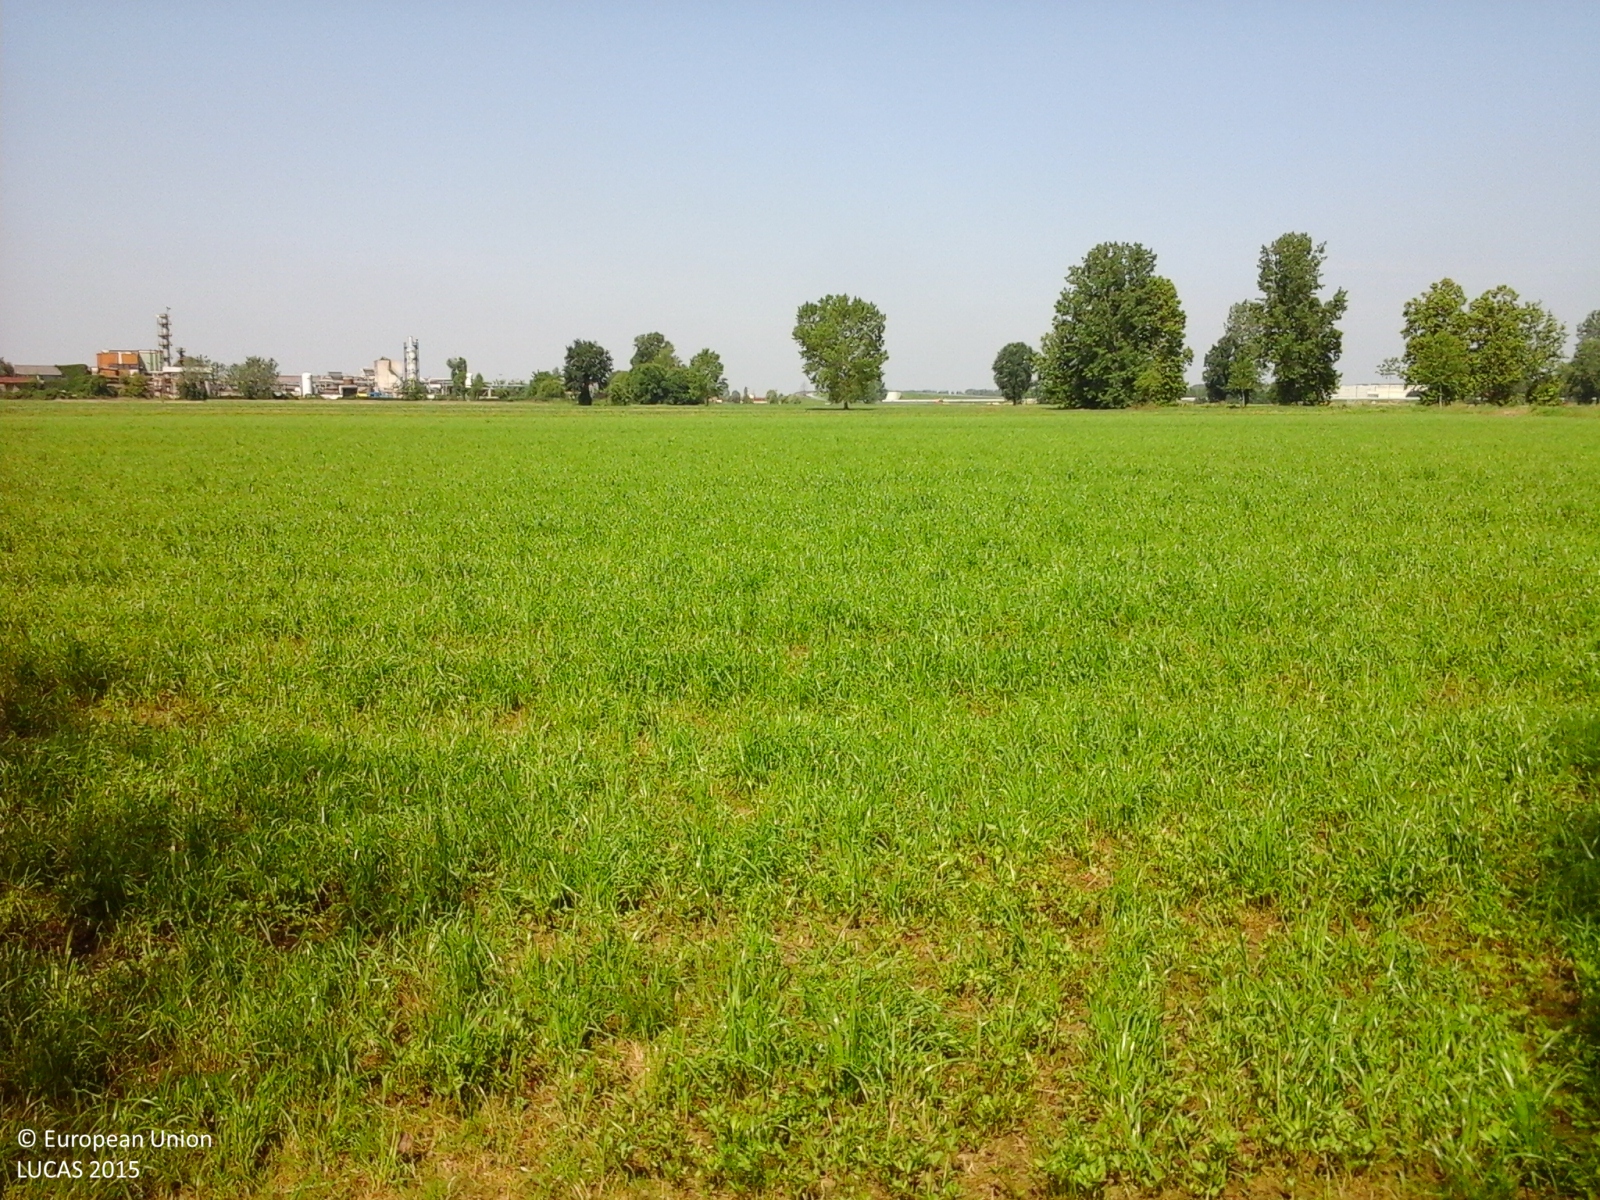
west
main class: Woodland
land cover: Broadleaved woodland
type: mesophytic deciduous forest
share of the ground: > 75 %
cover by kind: broadleaved forest trees 90 %, shrubs 10 %
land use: Semi-natural and natural areas not in use
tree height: > 5 m
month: May
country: IT
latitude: 45.3946
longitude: 9.4007
